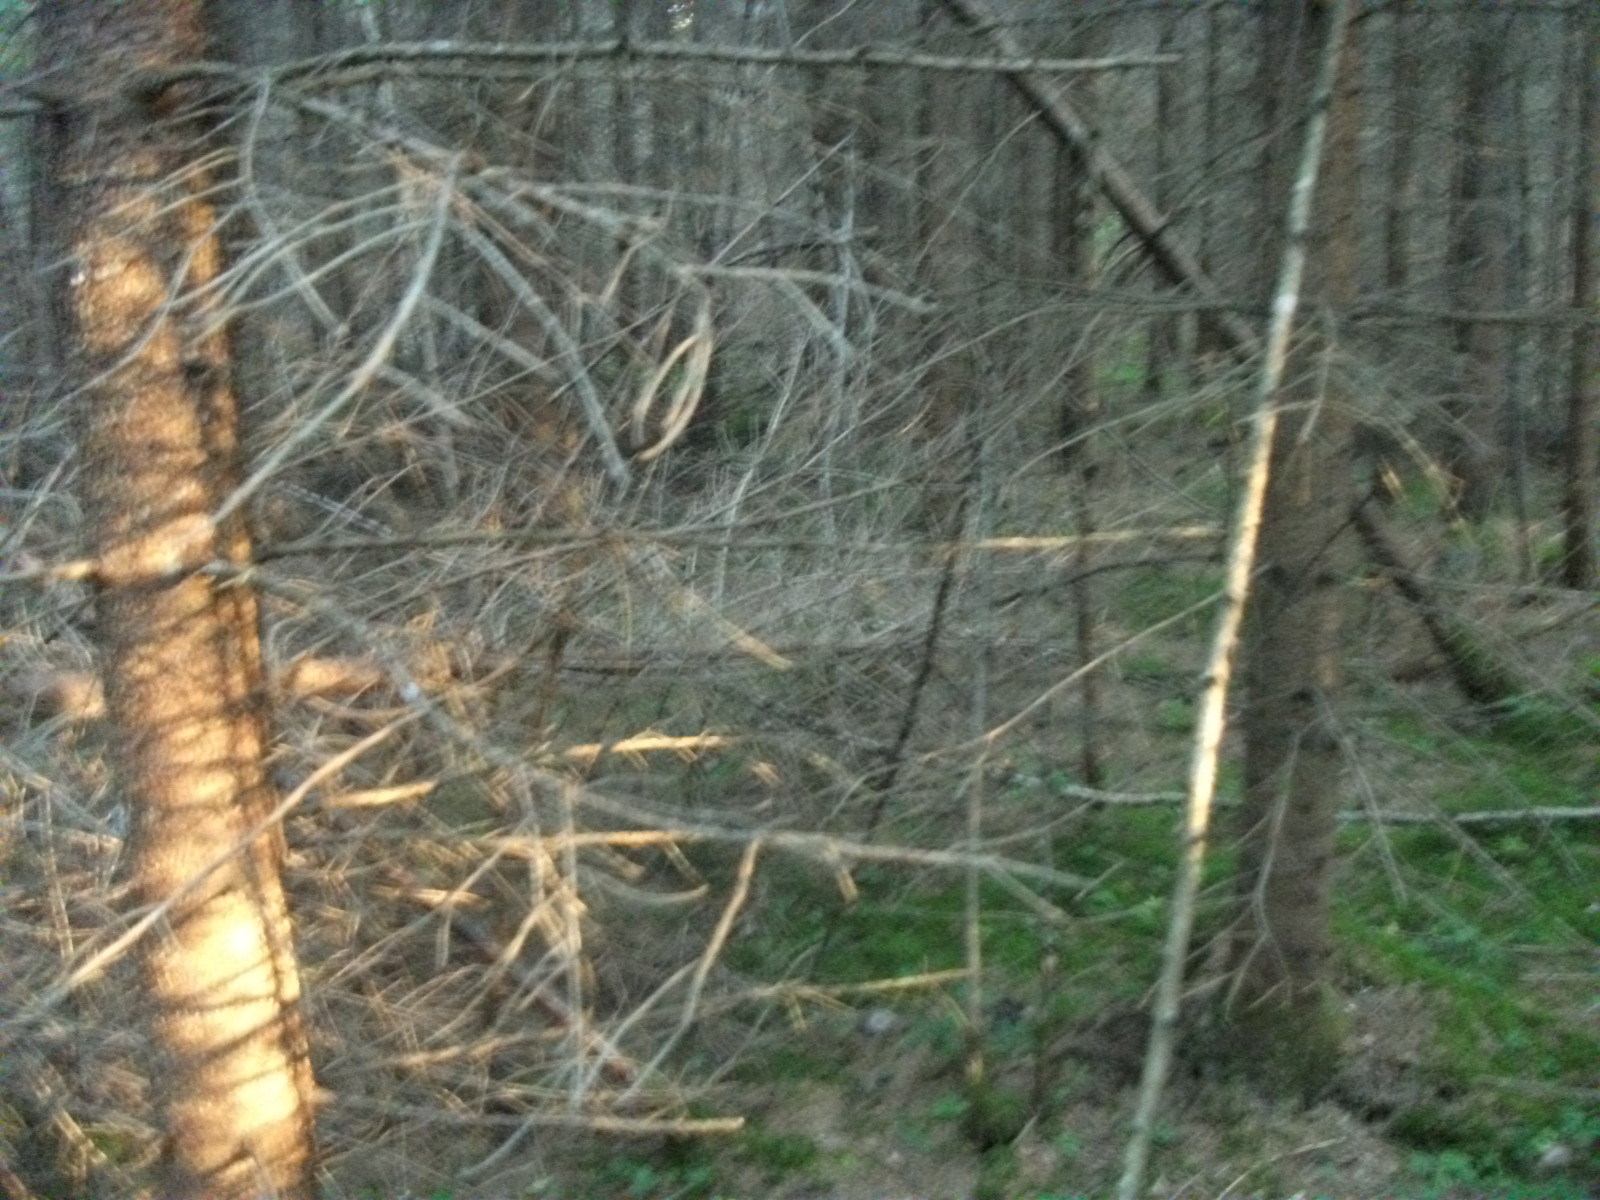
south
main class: Woodland
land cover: Spruce dominated coniferous woodland
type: hemiboreal forest and nemoral coniferous forest and mixed broadleaved-coniferous forest
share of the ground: > 75 %
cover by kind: coniferous forest trees 80 %, herbaceous plants 10 %, lichens and mosses 10 %
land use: Forestry
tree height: > 5 m
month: July
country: LV
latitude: 56.7877
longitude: 26.4659
